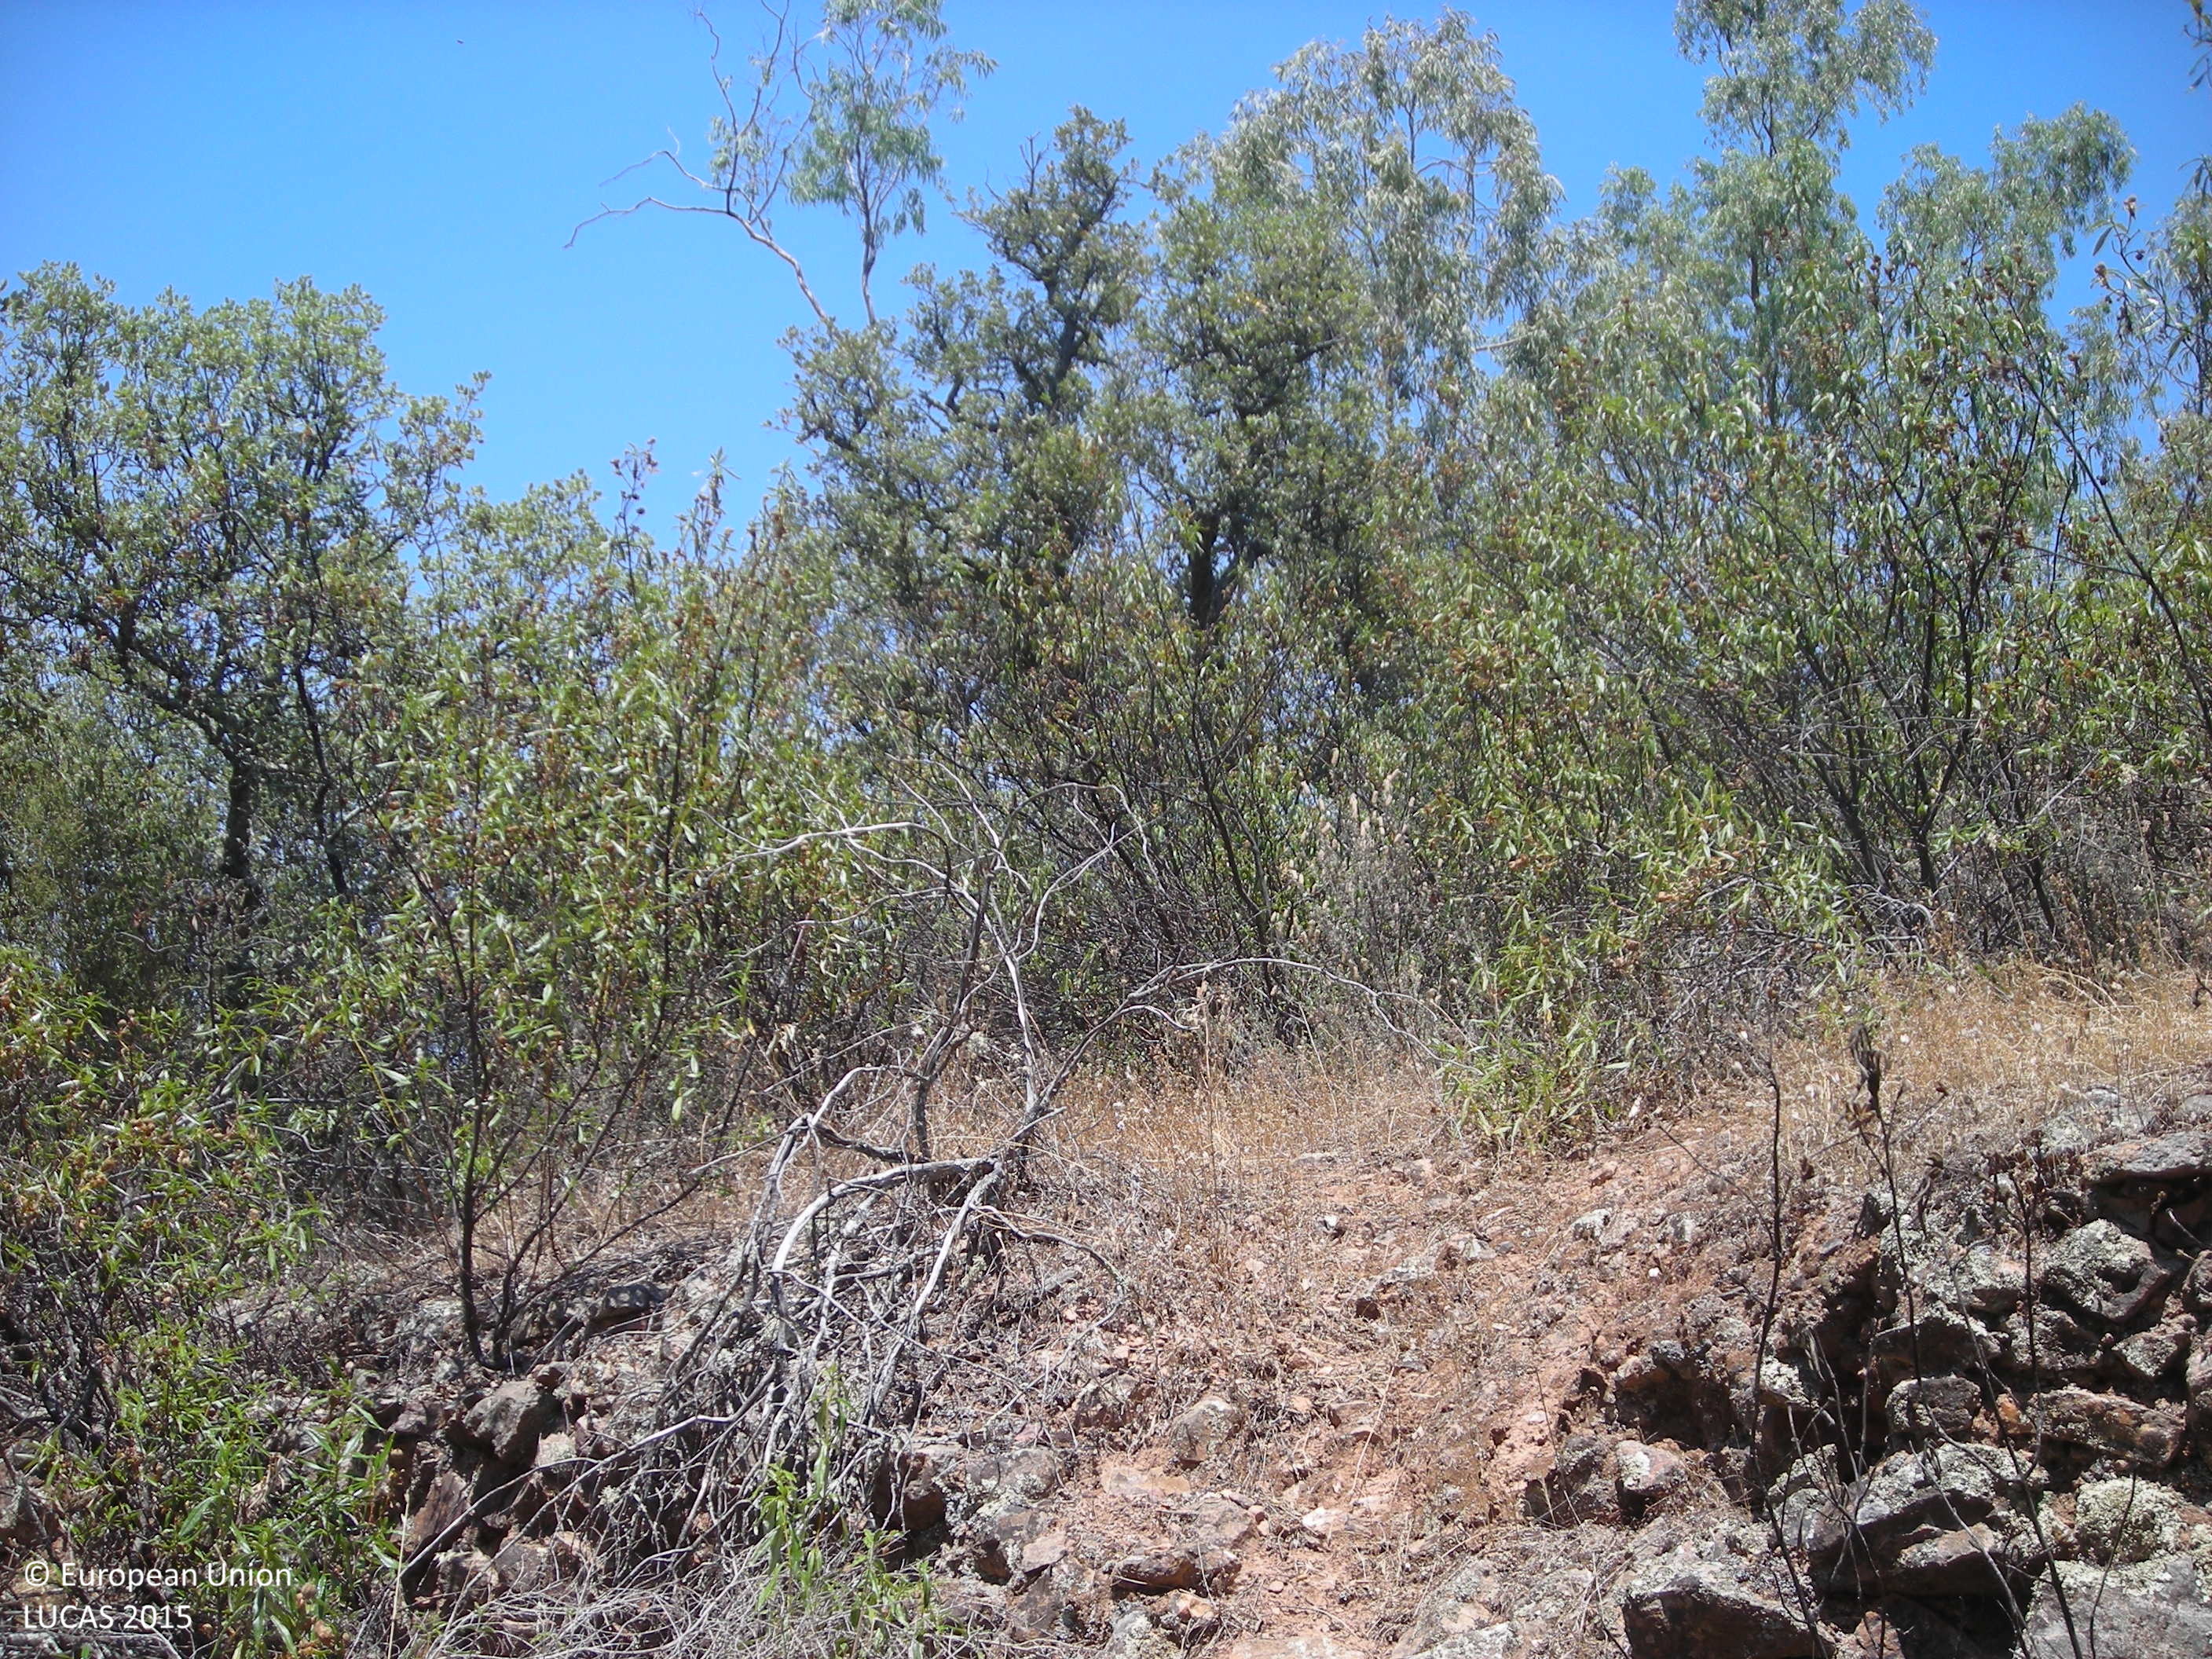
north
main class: Shrubland
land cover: Shrubland without tree cover
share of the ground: > 75 %
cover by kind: shrubs 100 %
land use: Semi-natural and natural areas not in use
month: June
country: ES
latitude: 39.0858
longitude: -5.4783
